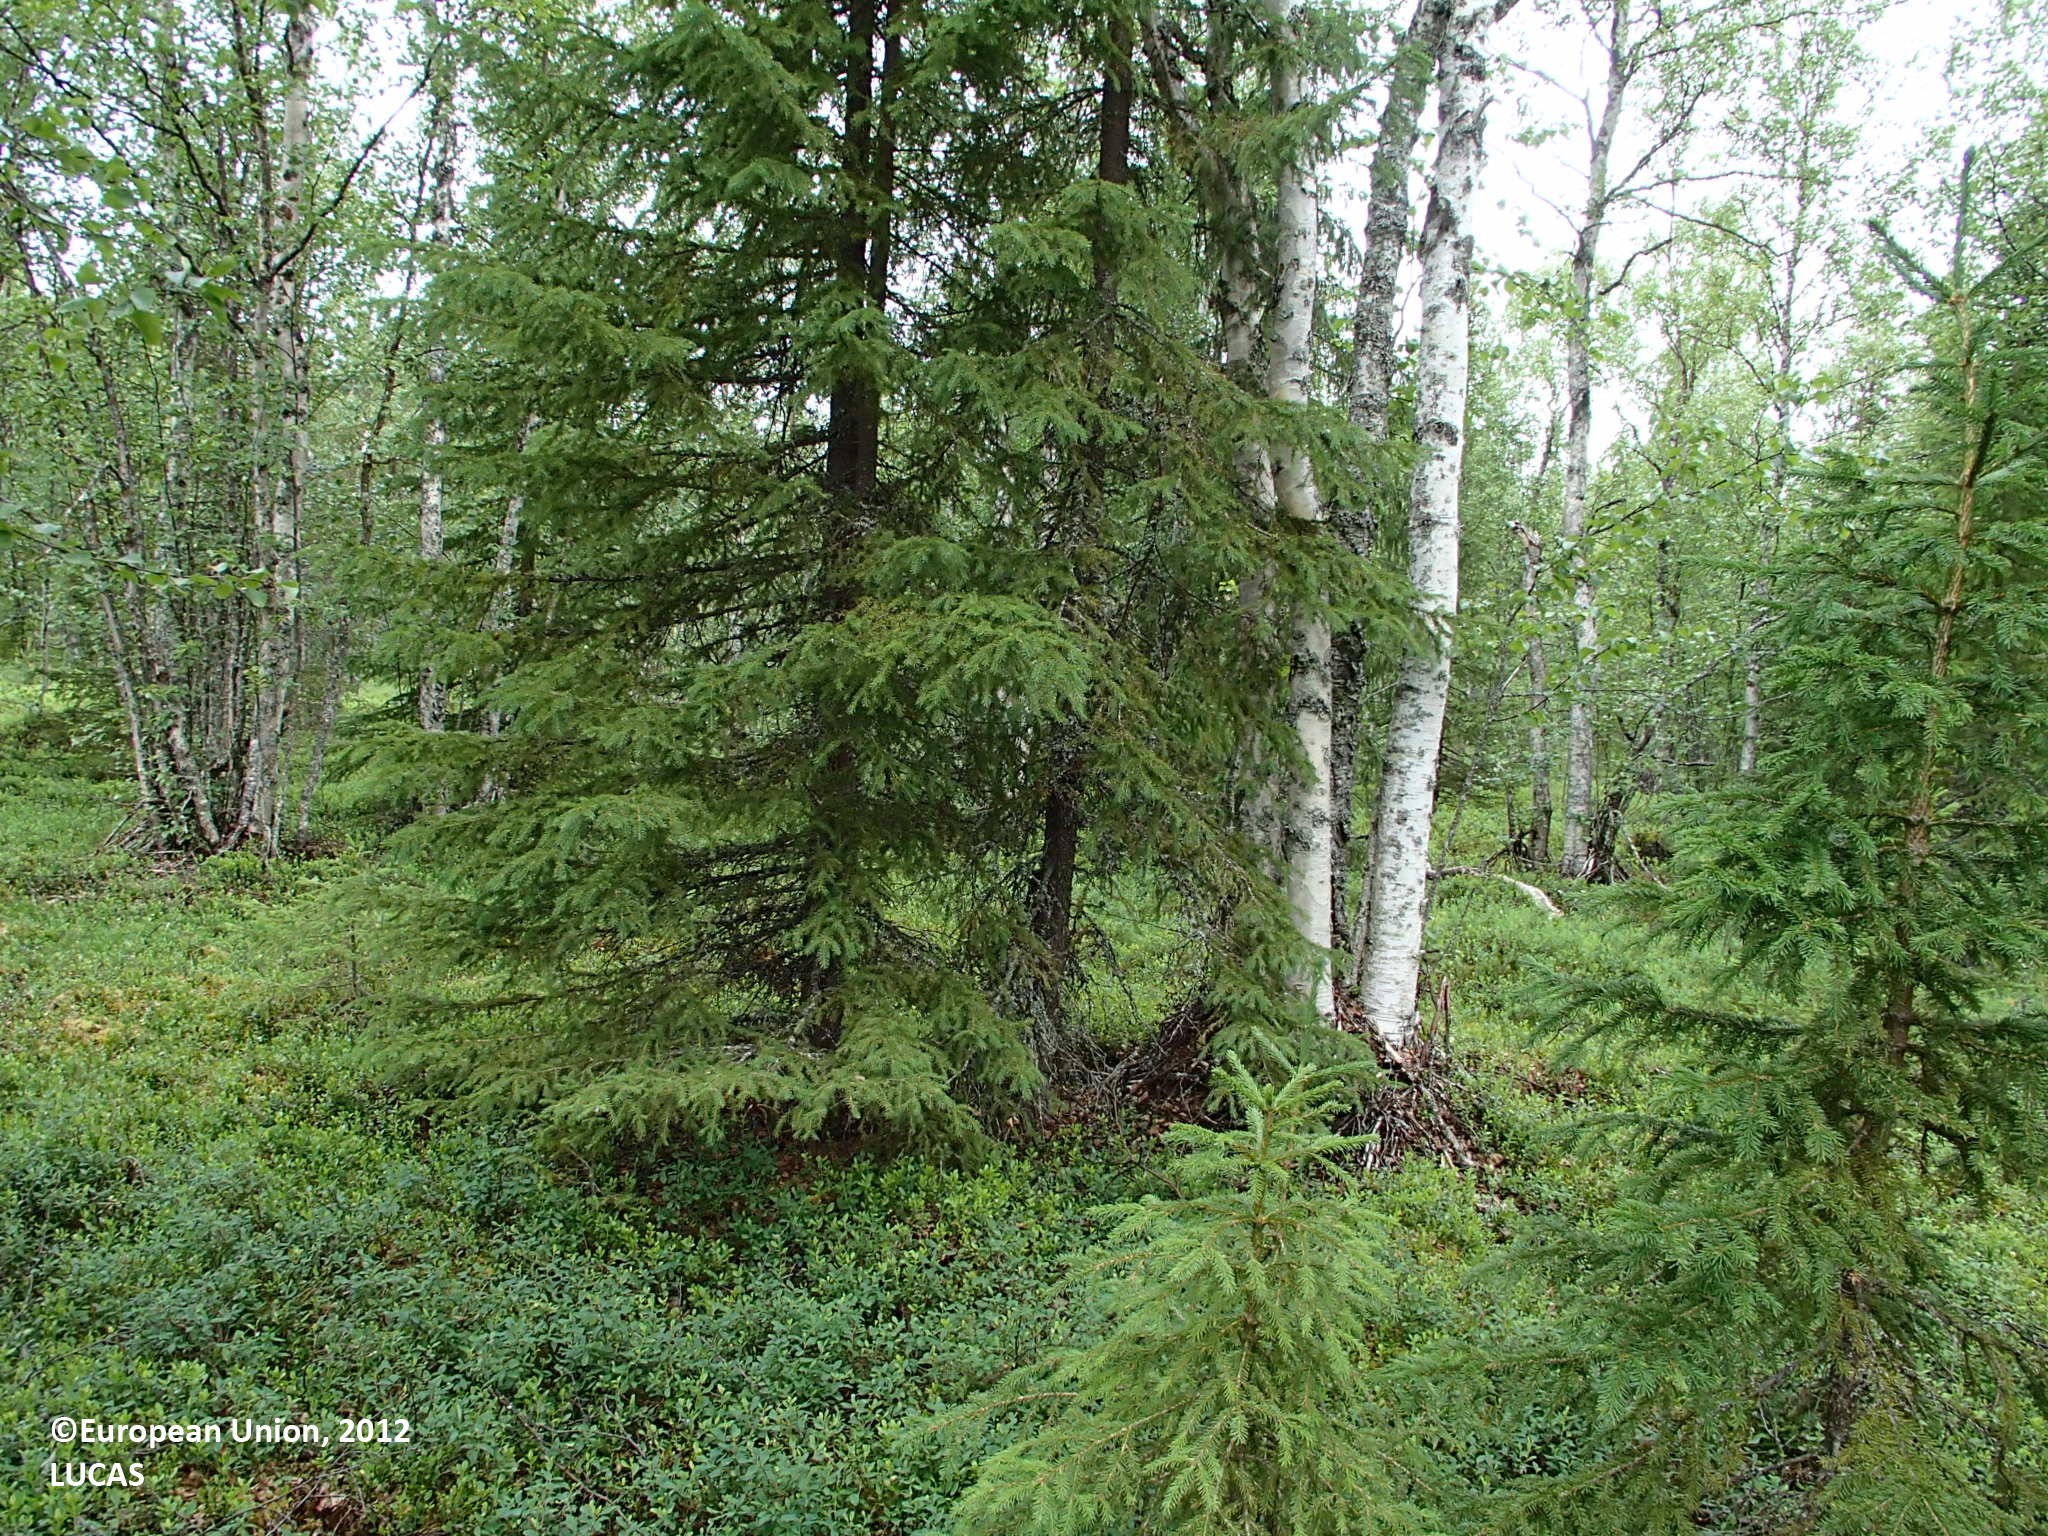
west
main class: Woodland
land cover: Other mixed woodland
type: boreal forest
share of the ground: > 75 %
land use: Forestry
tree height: > 5 m
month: July
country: FI
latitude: 67.0144
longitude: 25.5474
